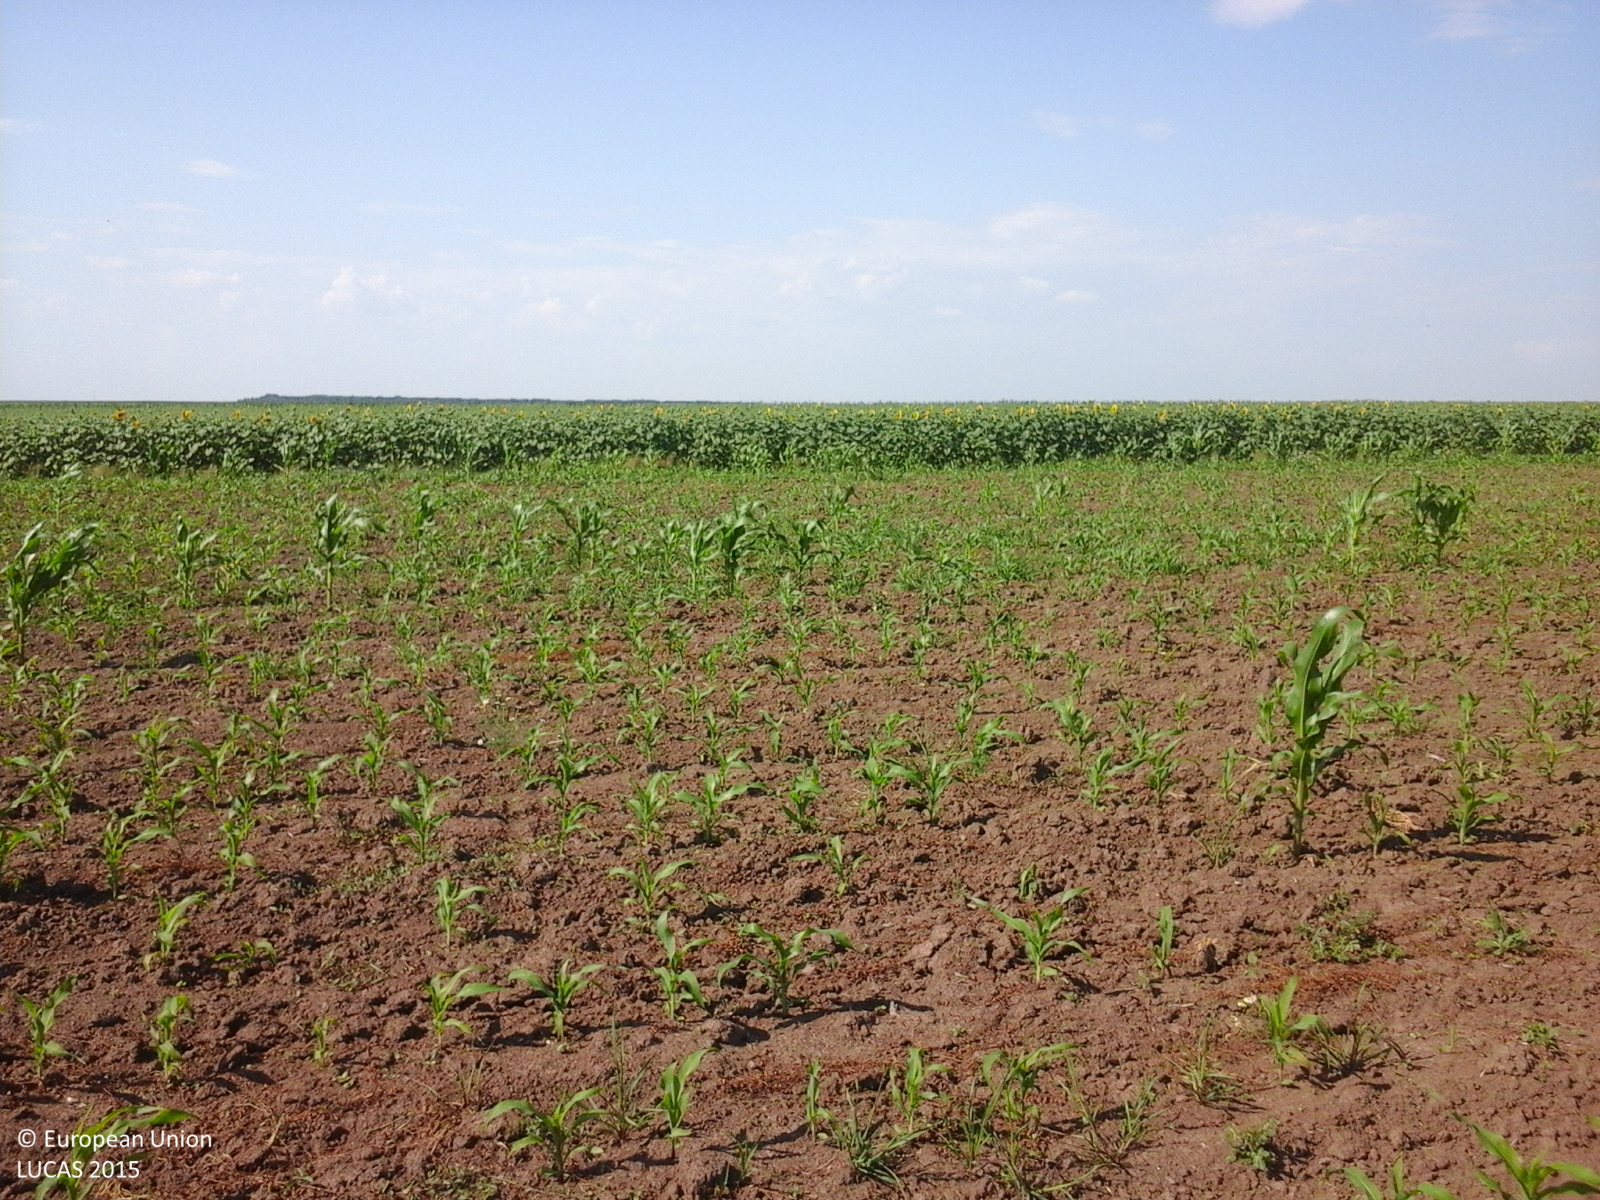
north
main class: Cropland
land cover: Maize
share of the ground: < 10 %
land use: Agriculture (excluding fallow land and kitchen gardens)
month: July
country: RO
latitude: 44.5506
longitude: 24.6384
